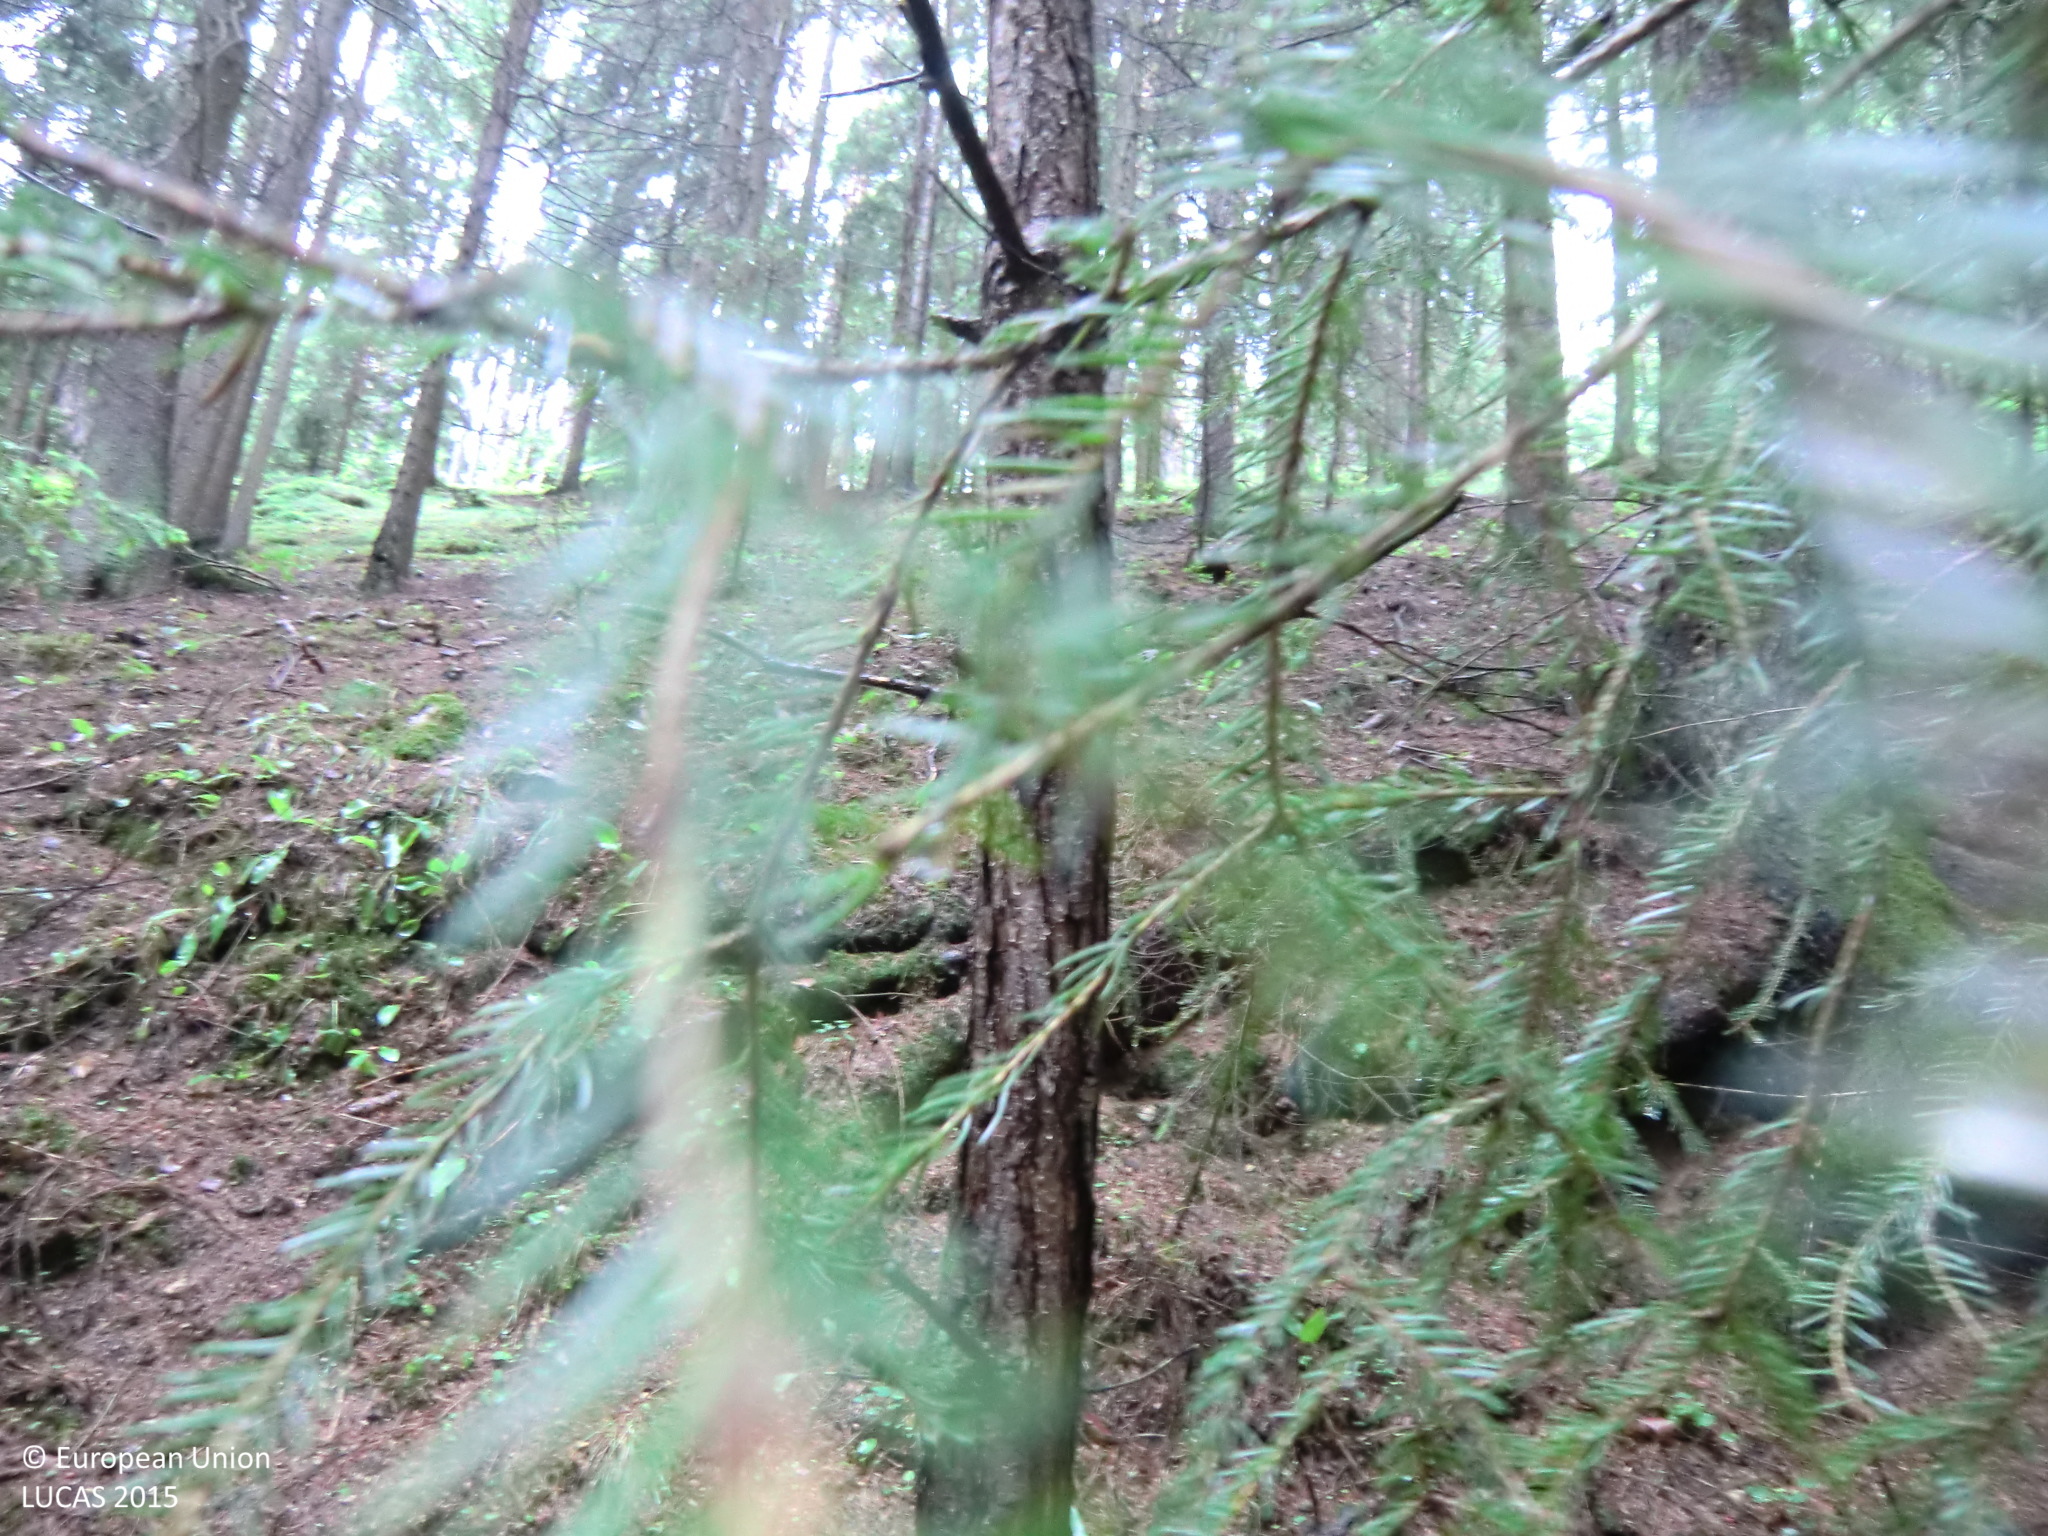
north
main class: Woodland
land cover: Spruce dominated coniferous woodland
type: hemiboreal forest and nemoral coniferous forest and mixed broadleaved-coniferous forest
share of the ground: > 75 %
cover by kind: coniferous forest trees 90 %, herbaceous plants 5 %, unconsolidated bare surface 5 %
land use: Forestry
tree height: > 5 m
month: June
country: AT
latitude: 48.5300
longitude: 14.4559
